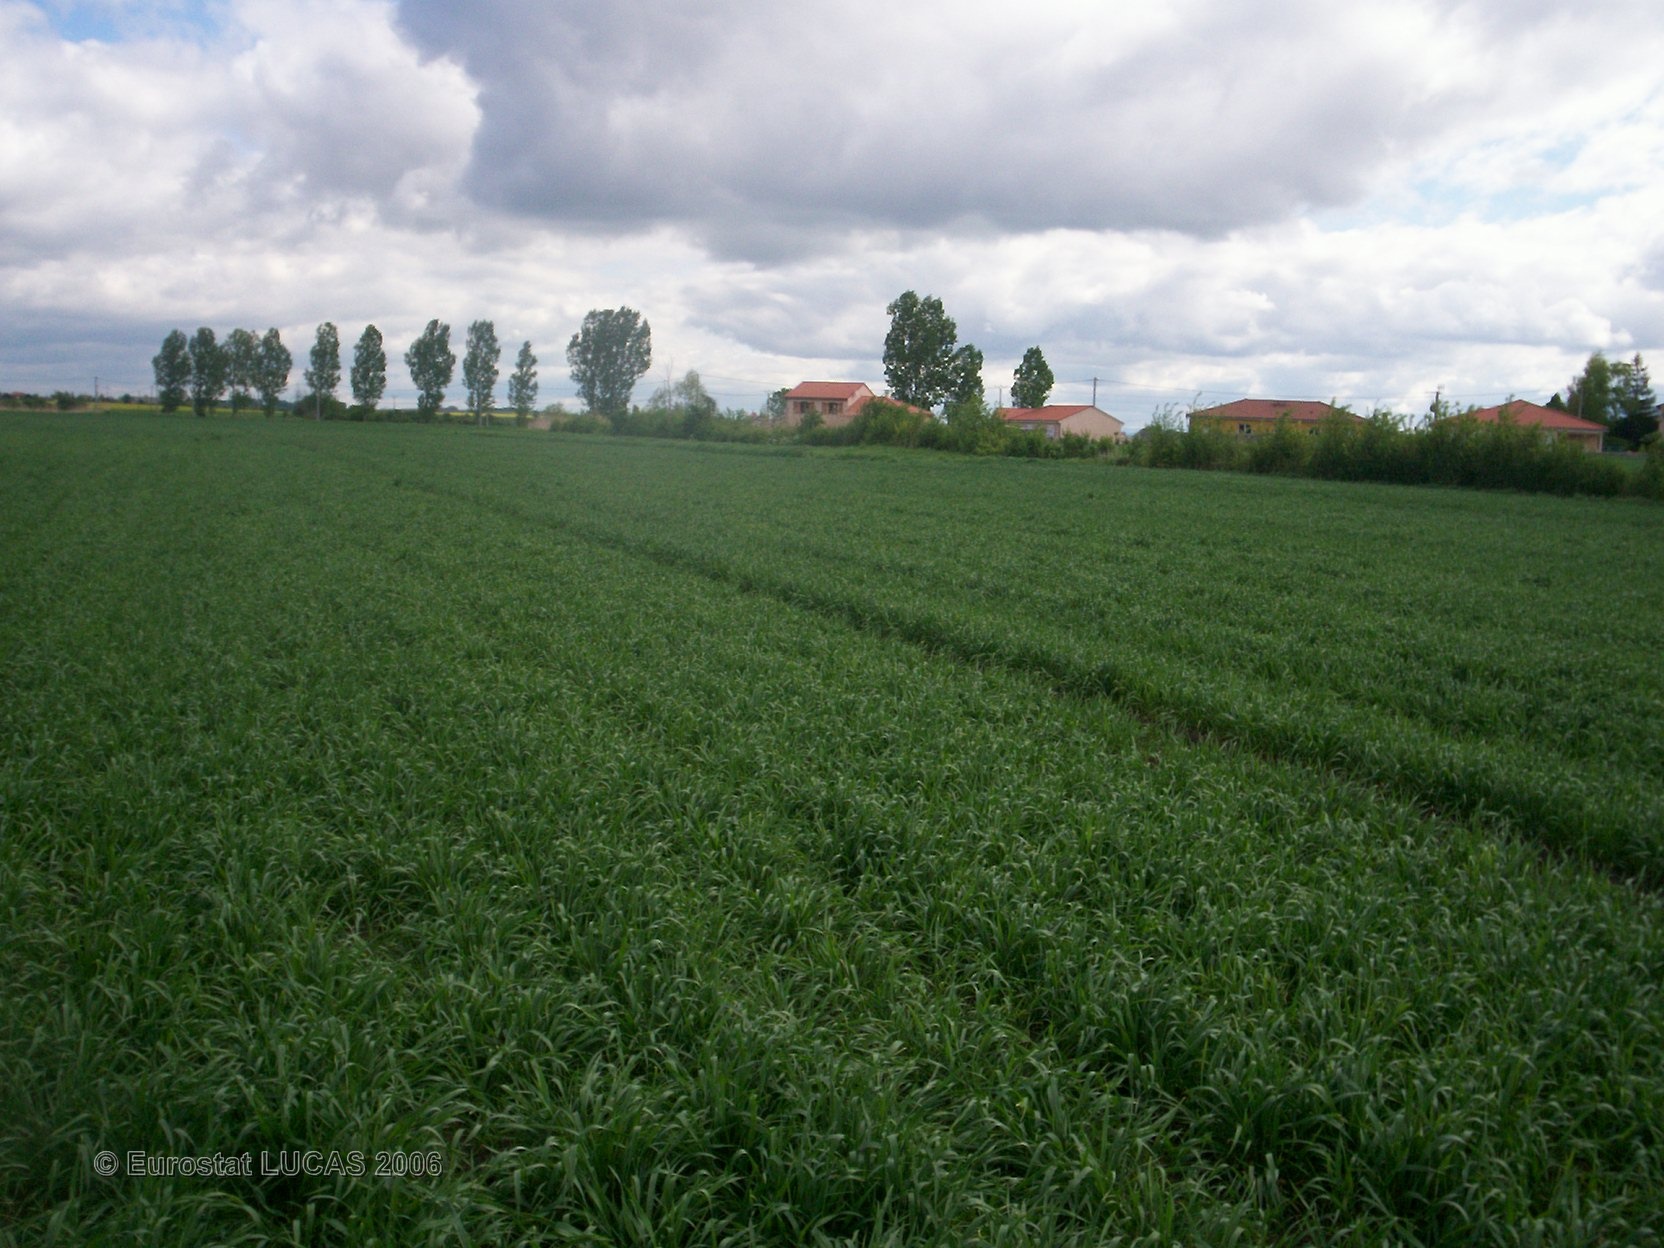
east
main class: Cropland
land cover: Barley
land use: Agriculture (excluding fallow land and kitchen gardens)
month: May
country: FR
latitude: 45.9148
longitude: 3.1535
